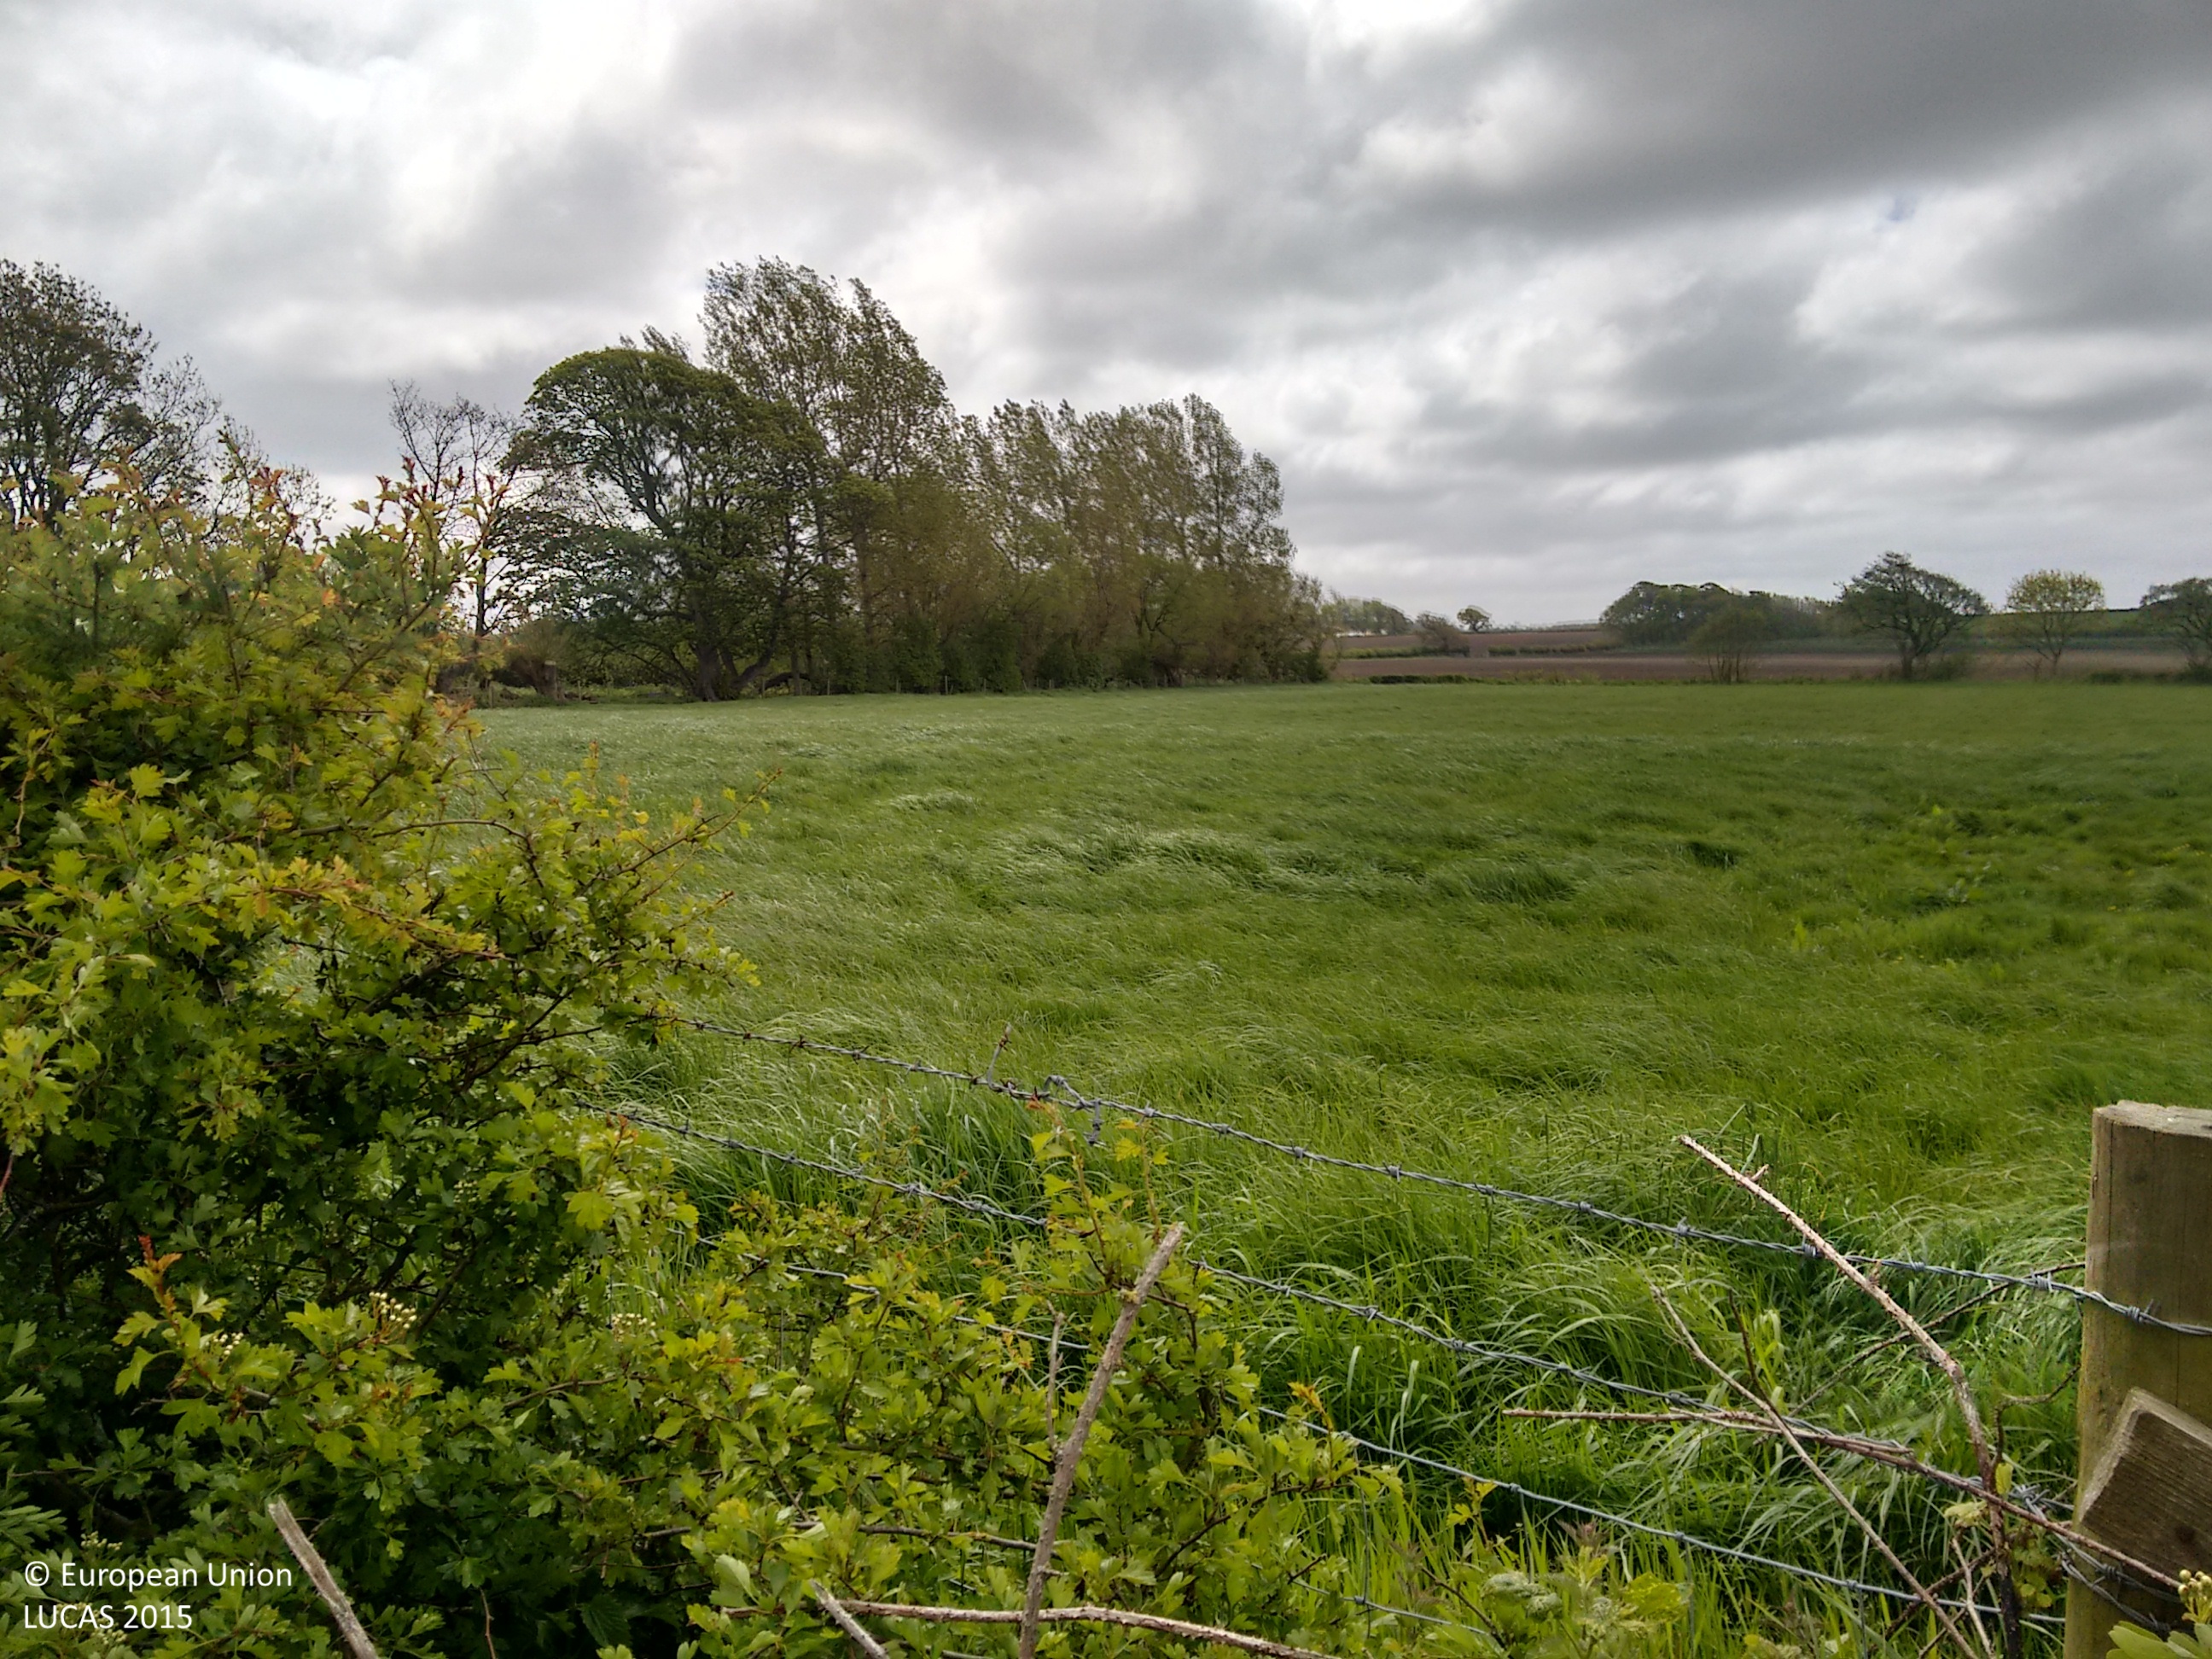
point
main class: Grassland
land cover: Grassland without tree/shrub cover
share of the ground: > 75 %
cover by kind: herbaceous plants 100 %
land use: Agriculture (excluding fallow land and kitchen gardens)
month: May
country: GB
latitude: 53.8012
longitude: -2.9019
